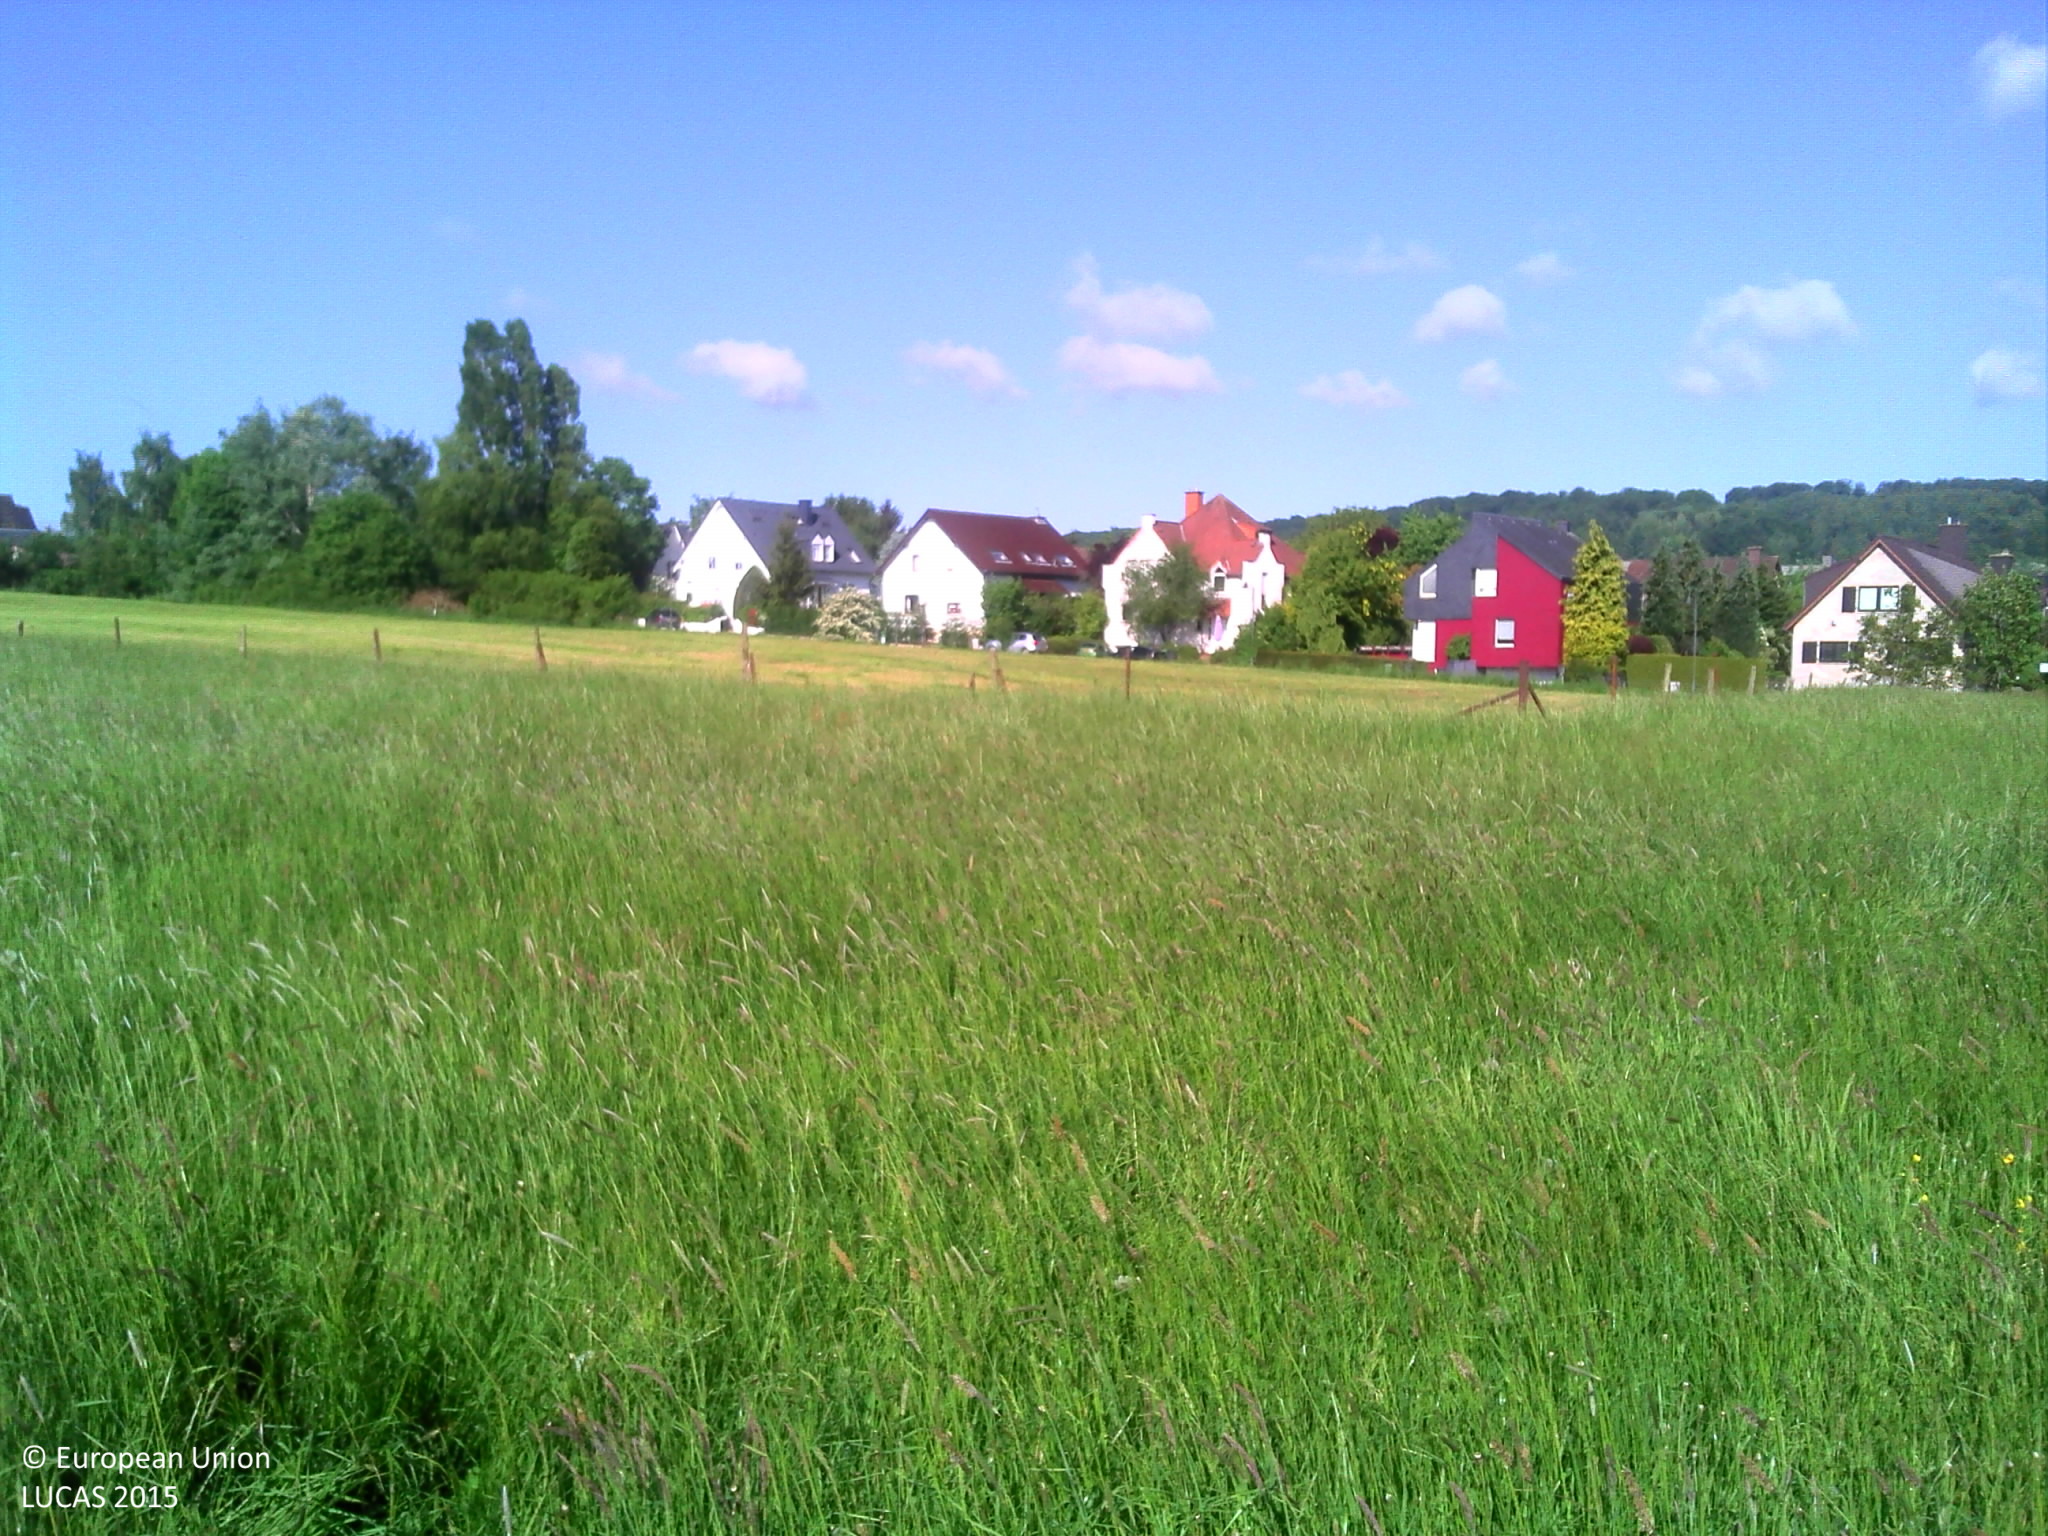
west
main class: Grassland
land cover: Grassland without tree/shrub cover
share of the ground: > 75 %
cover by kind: herbaceous plants 100 %
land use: Agriculture (excluding fallow land and kitchen gardens)
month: May
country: LU
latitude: 49.6194
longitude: 6.2761
